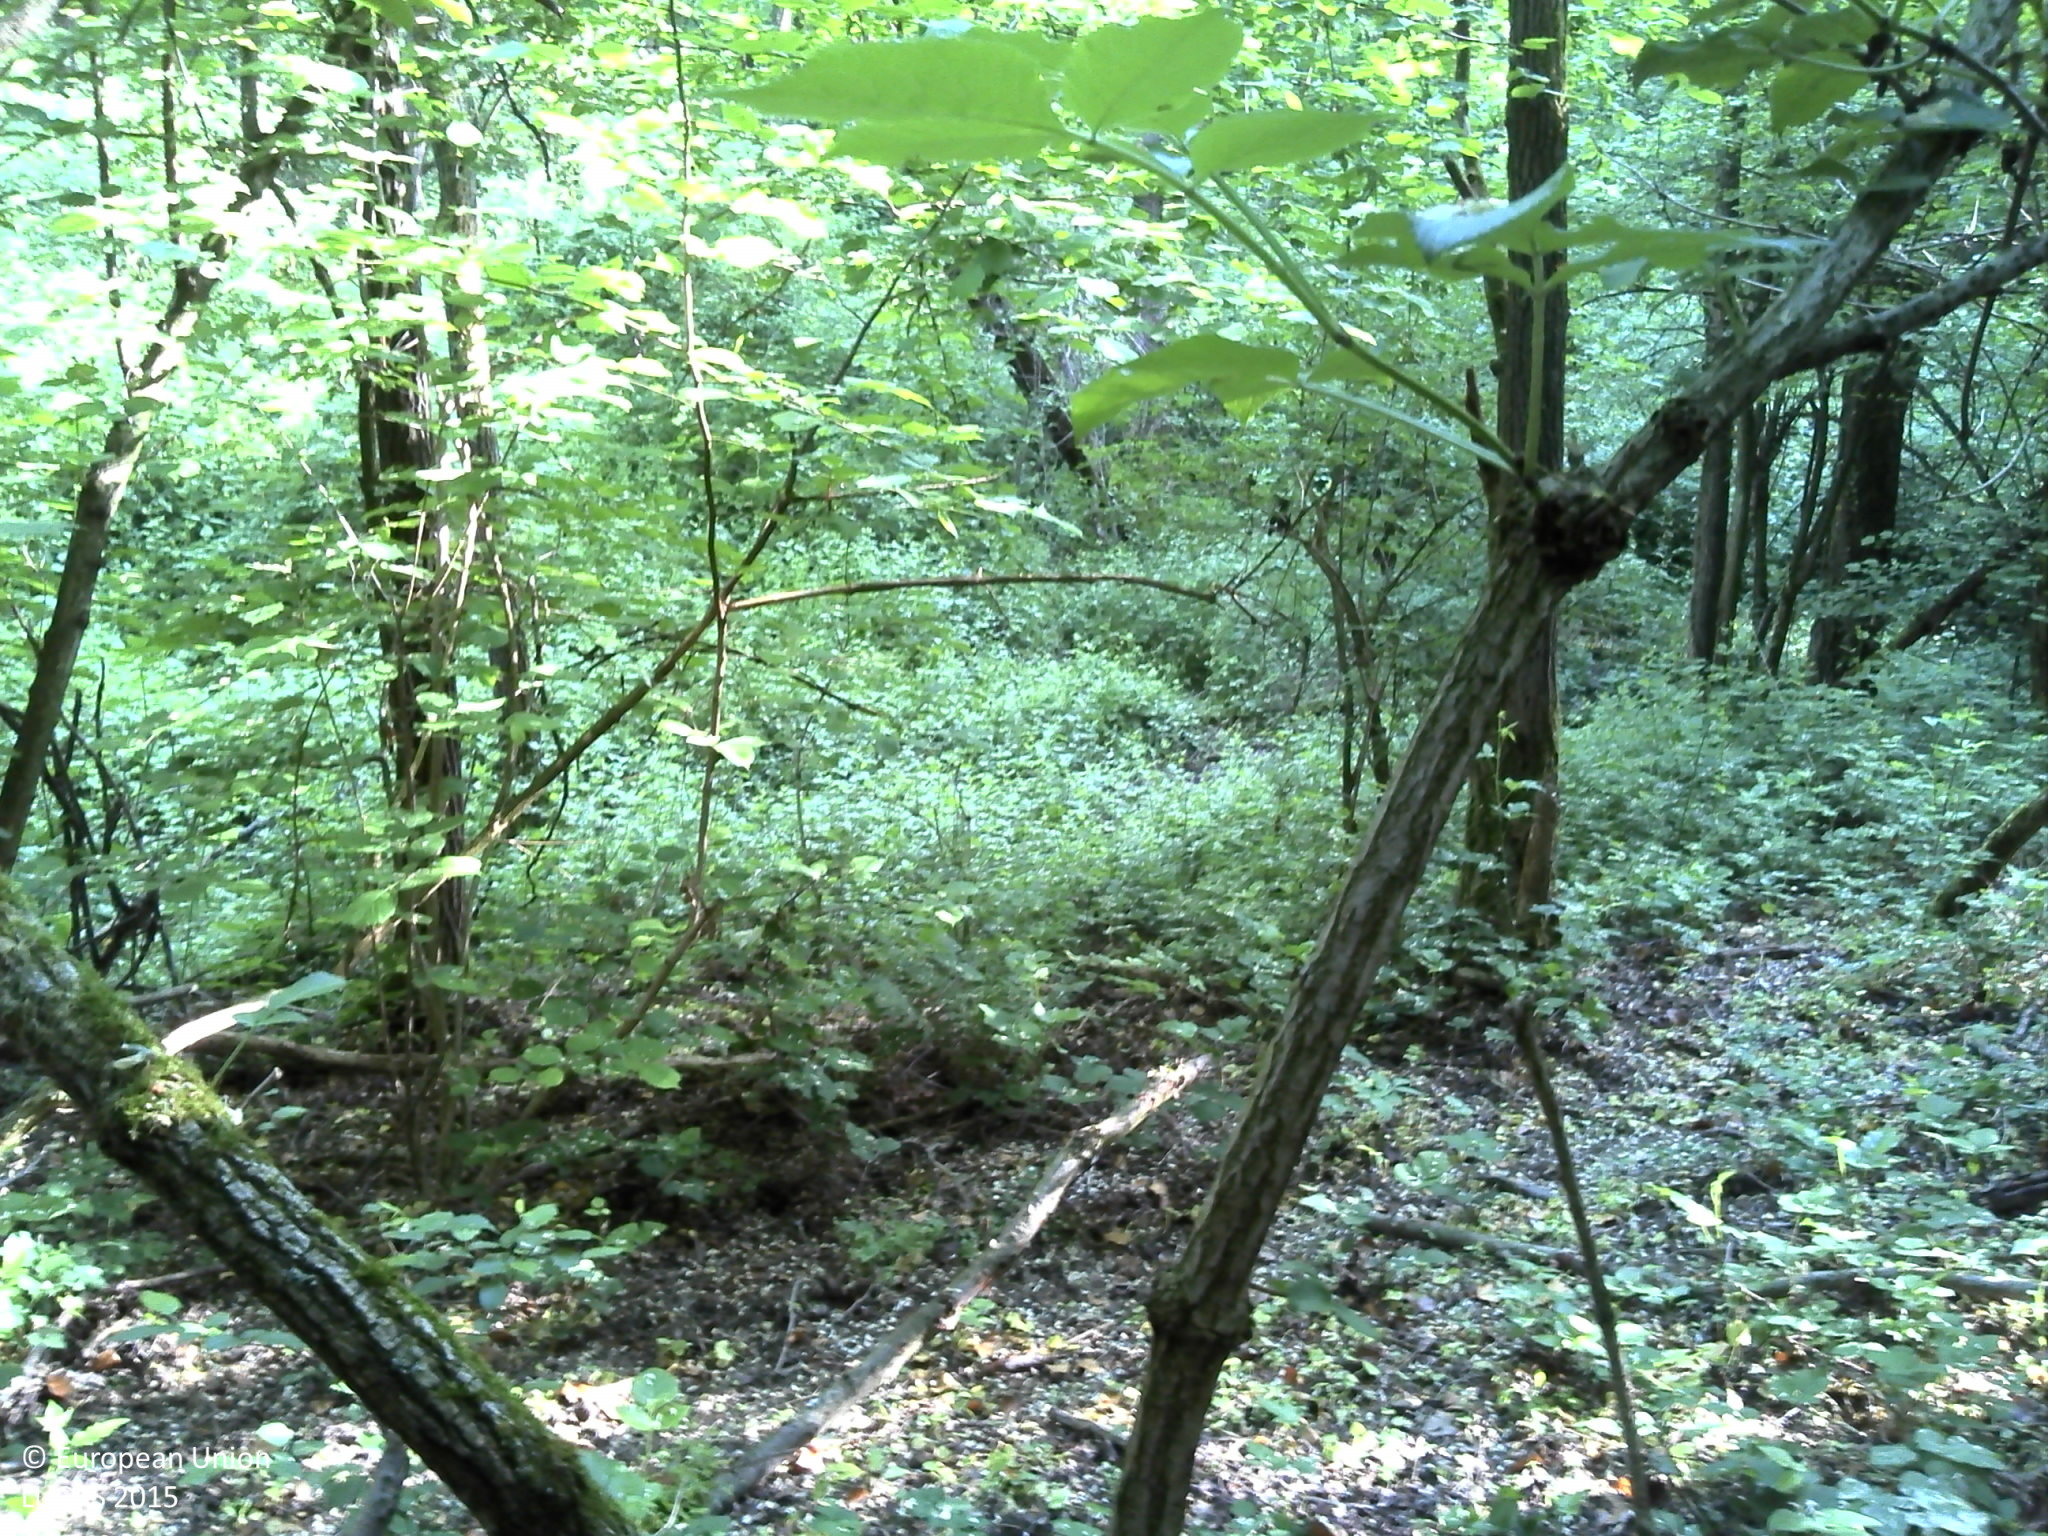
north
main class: Woodland
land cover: Broadleaved woodland
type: mesophytic deciduous forest
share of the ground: > 75 %
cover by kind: broadleaved forest trees 100 %
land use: Forestry
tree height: > 5 m
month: May
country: HR
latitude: 45.4939
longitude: 17.9500
